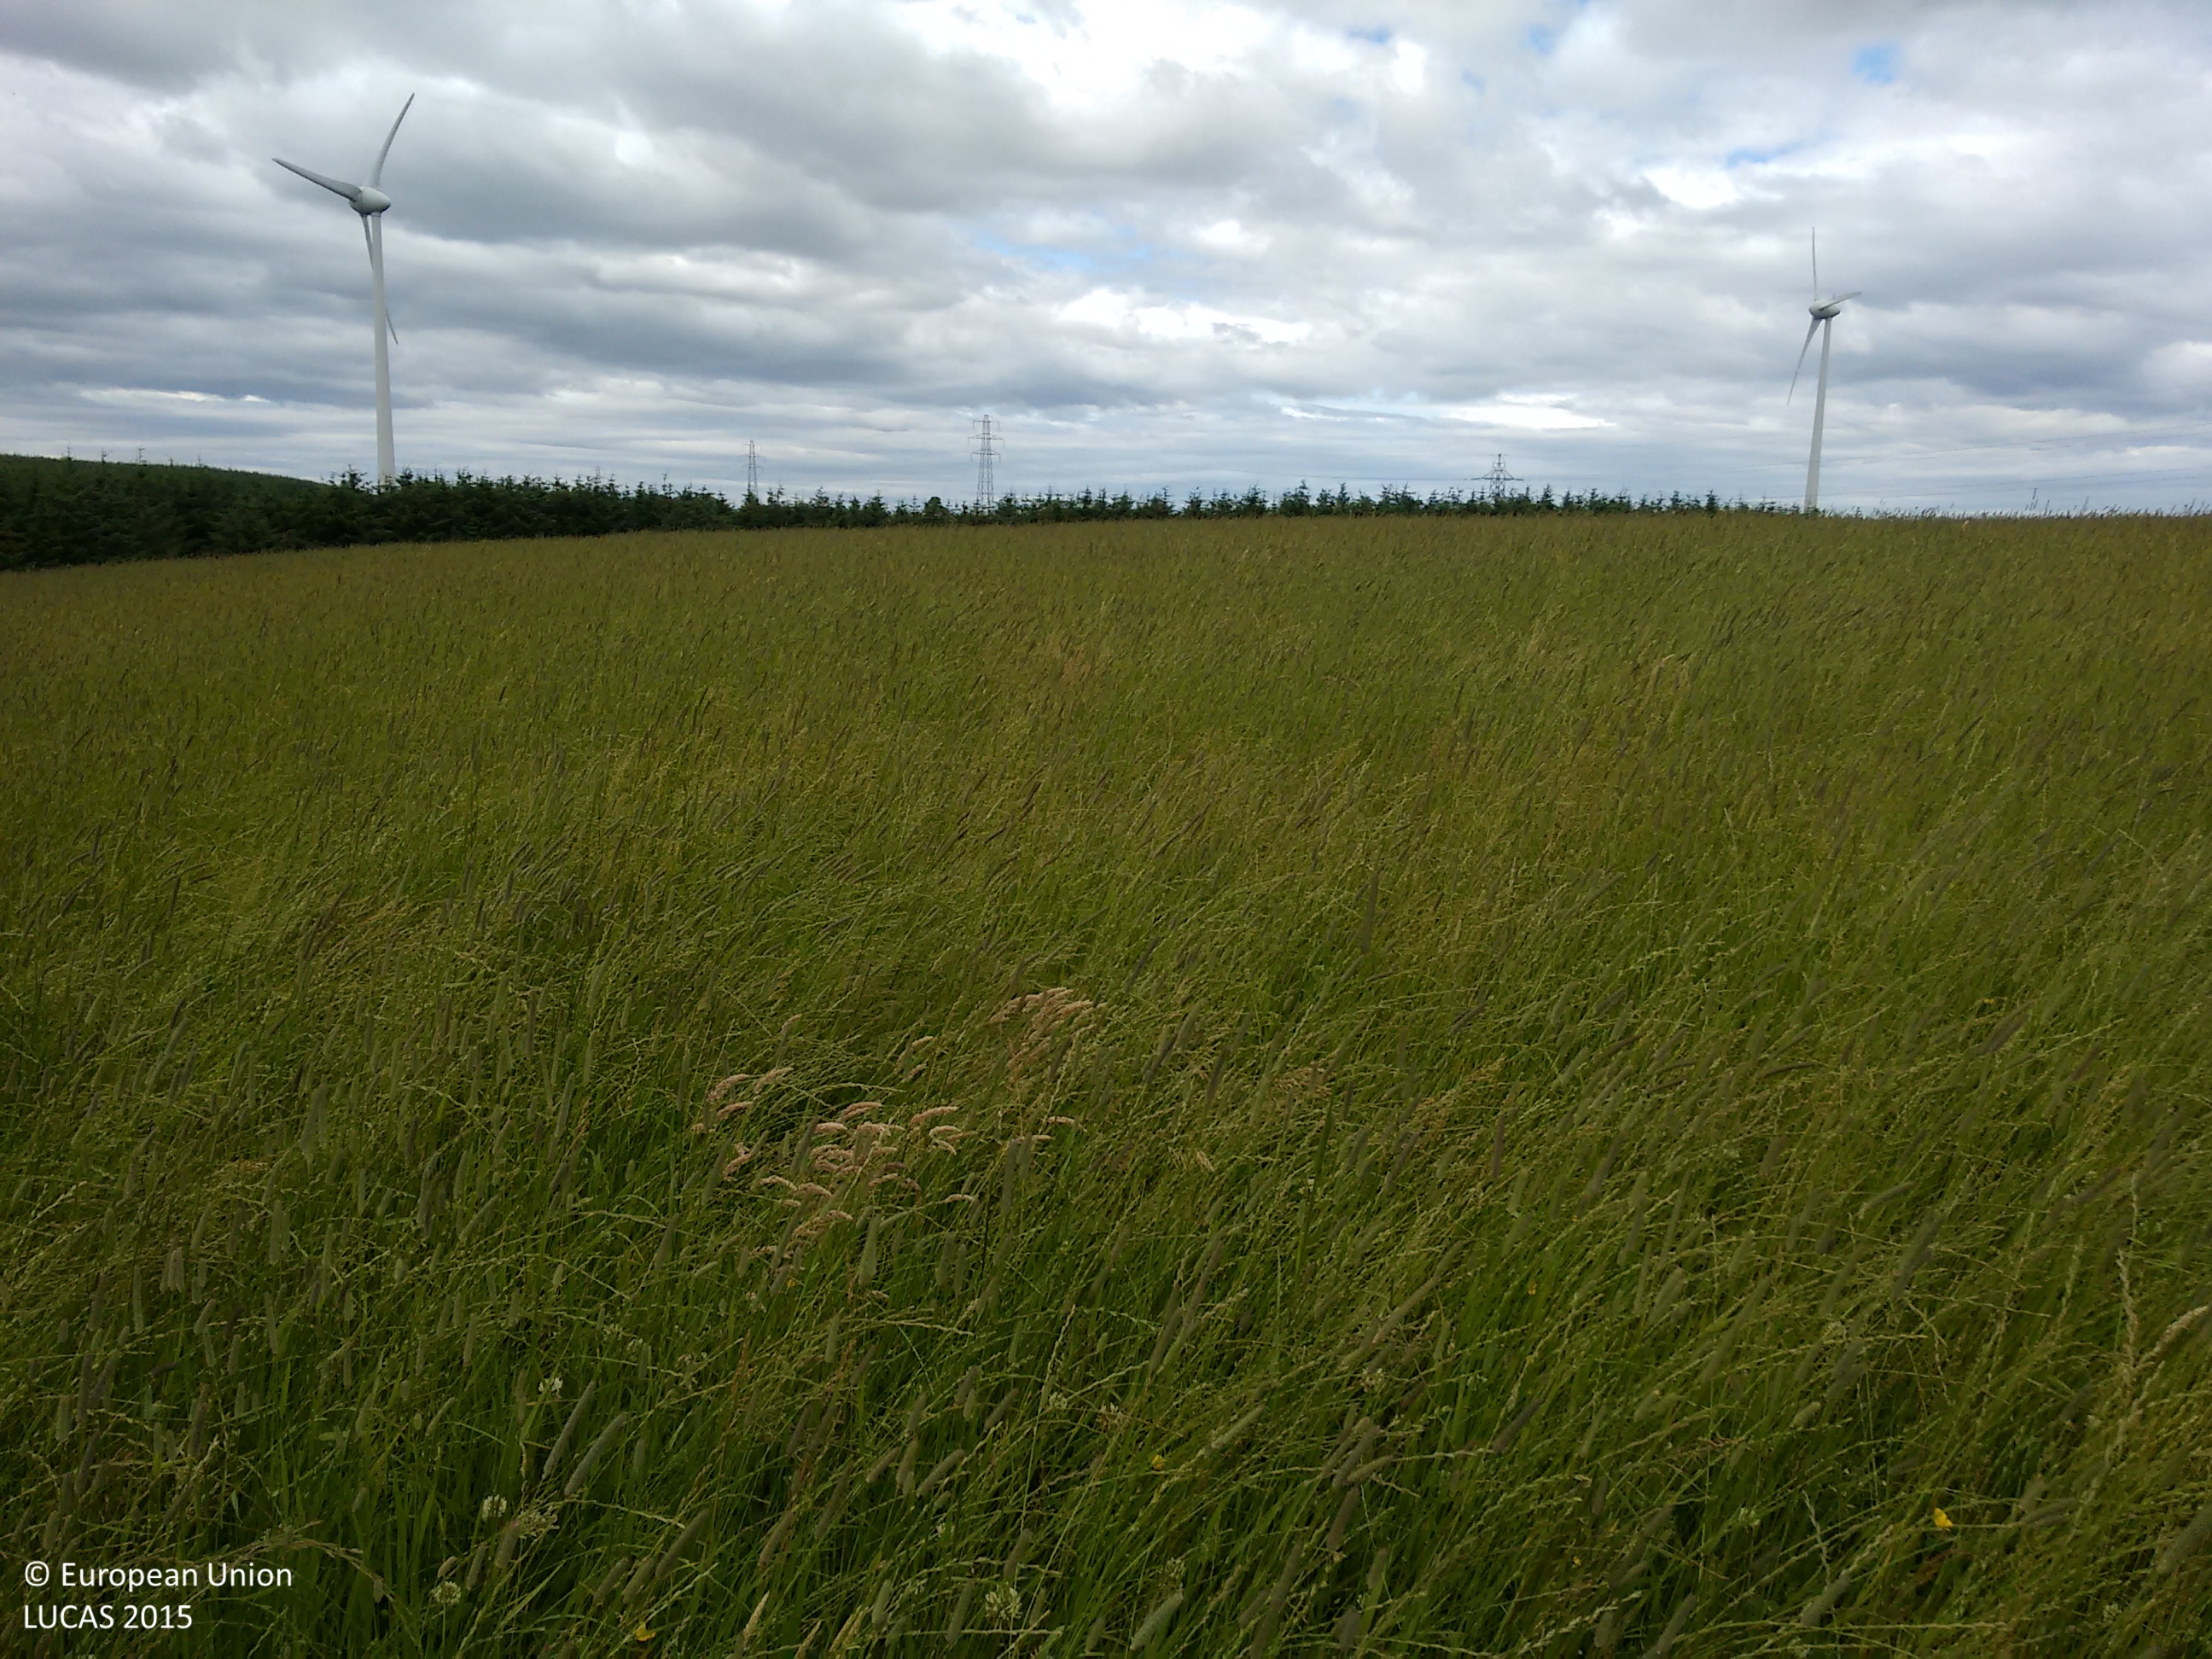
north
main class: Cropland
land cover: Temporary grasslands
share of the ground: > 75 %
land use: Agriculture (excluding fallow land and kitchen gardens)
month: July
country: GB
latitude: 57.5469
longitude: -1.8557
